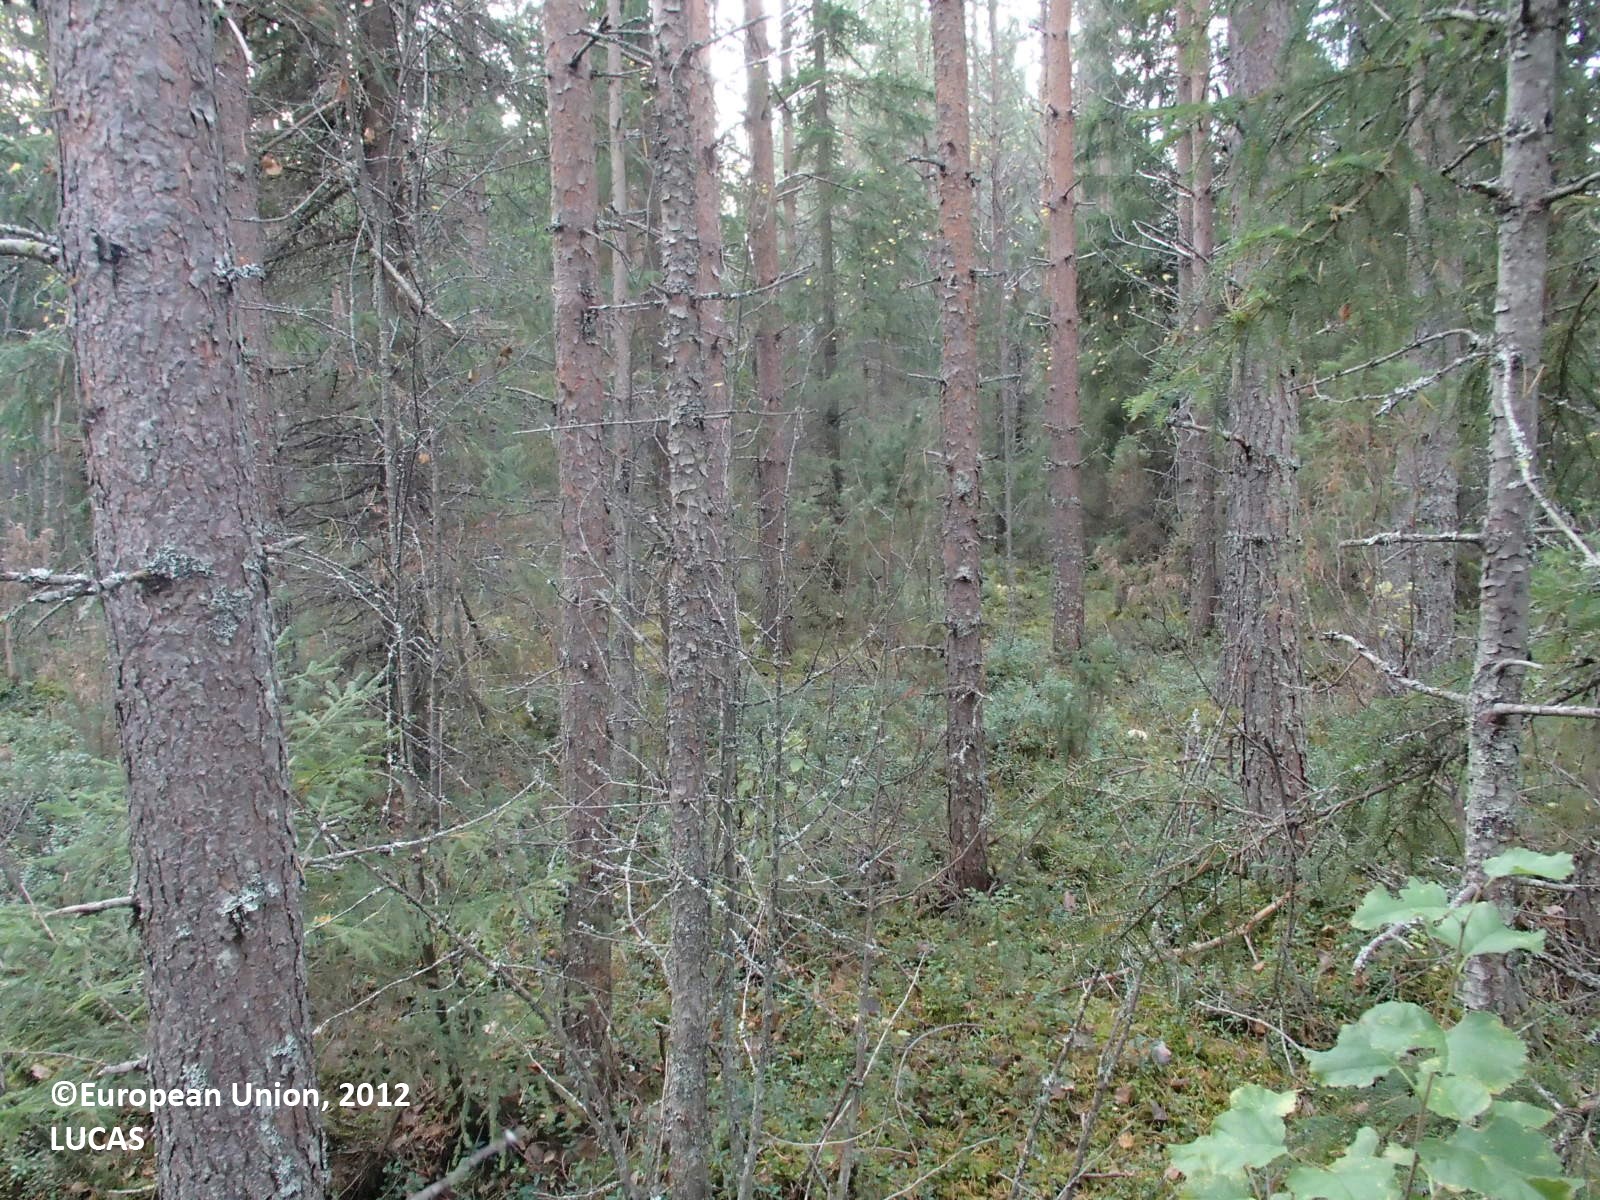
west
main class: Woodland
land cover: Other coniferous woodland
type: boreal forest
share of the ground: > 75 %
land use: Forestry
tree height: > 5 m
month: September
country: FI
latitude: 63.5911
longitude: 26.0541
